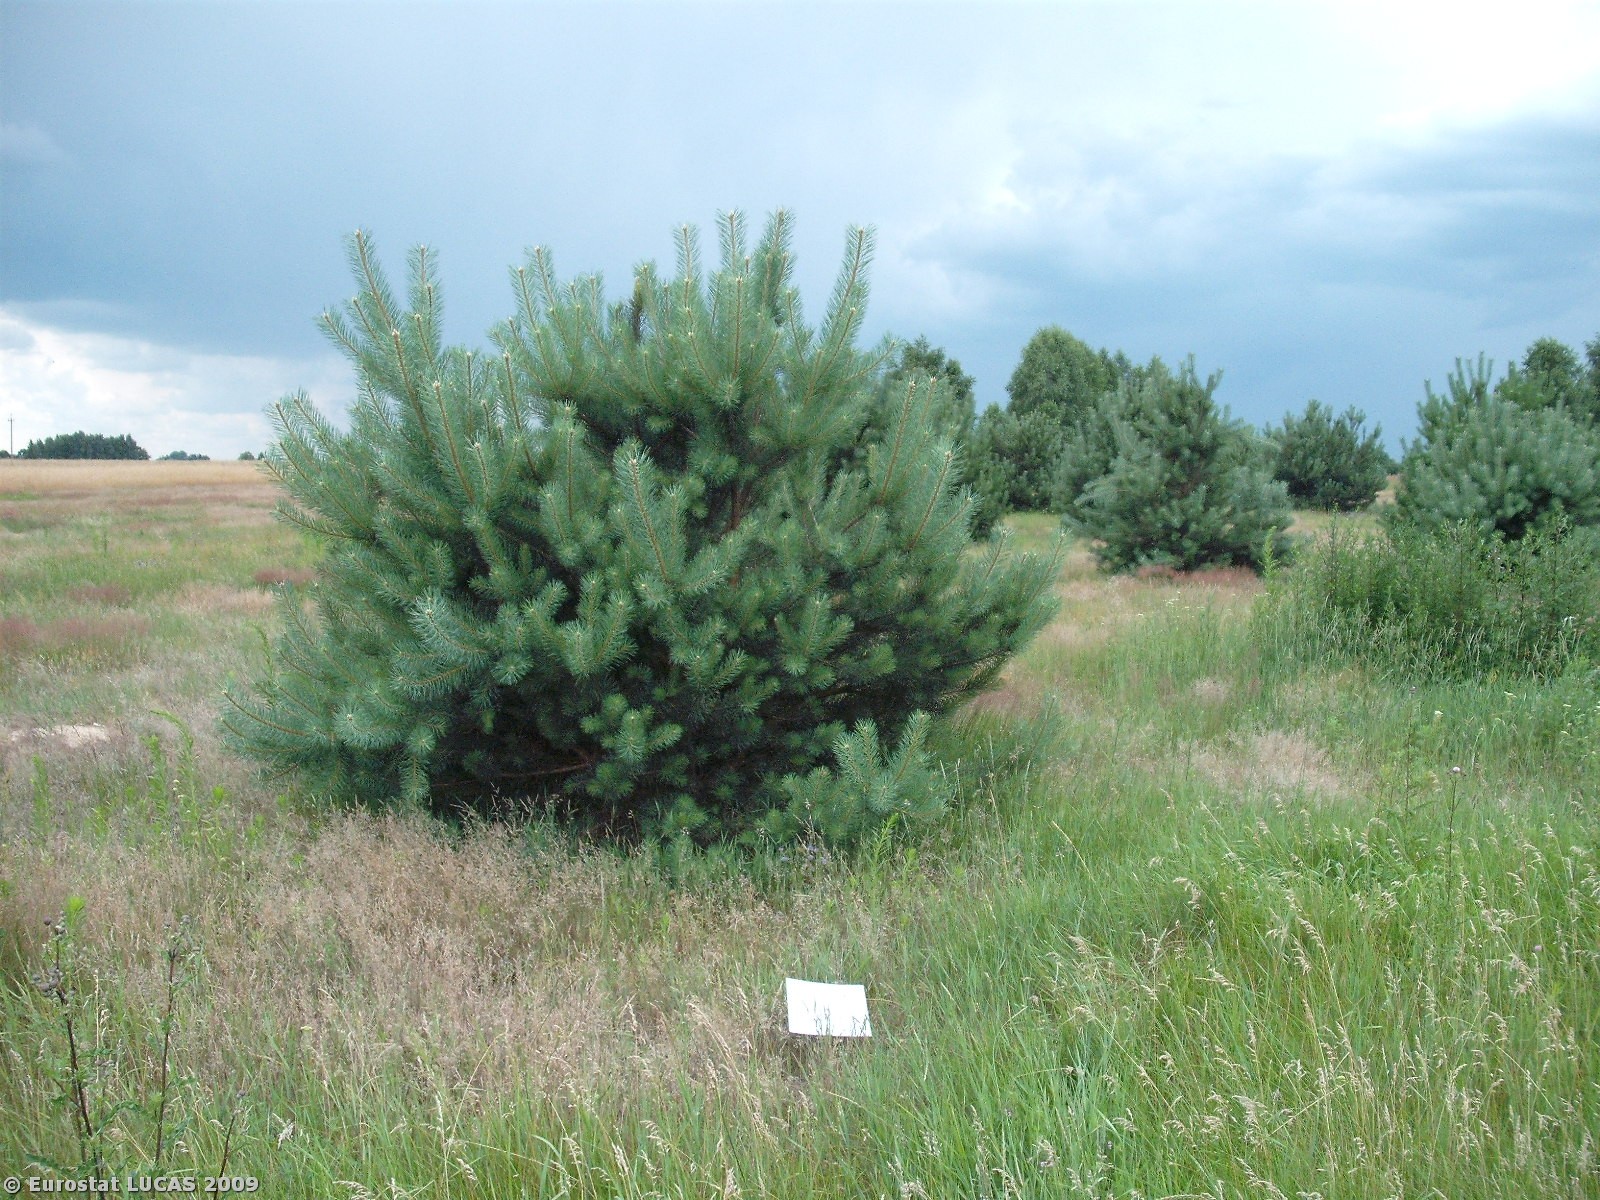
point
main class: Grassland
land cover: Grassland with sparse tree/shrub cover
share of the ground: > 75 %
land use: Unused
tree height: < 5 m
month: July
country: PL
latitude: 51.4777
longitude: 21.0601
